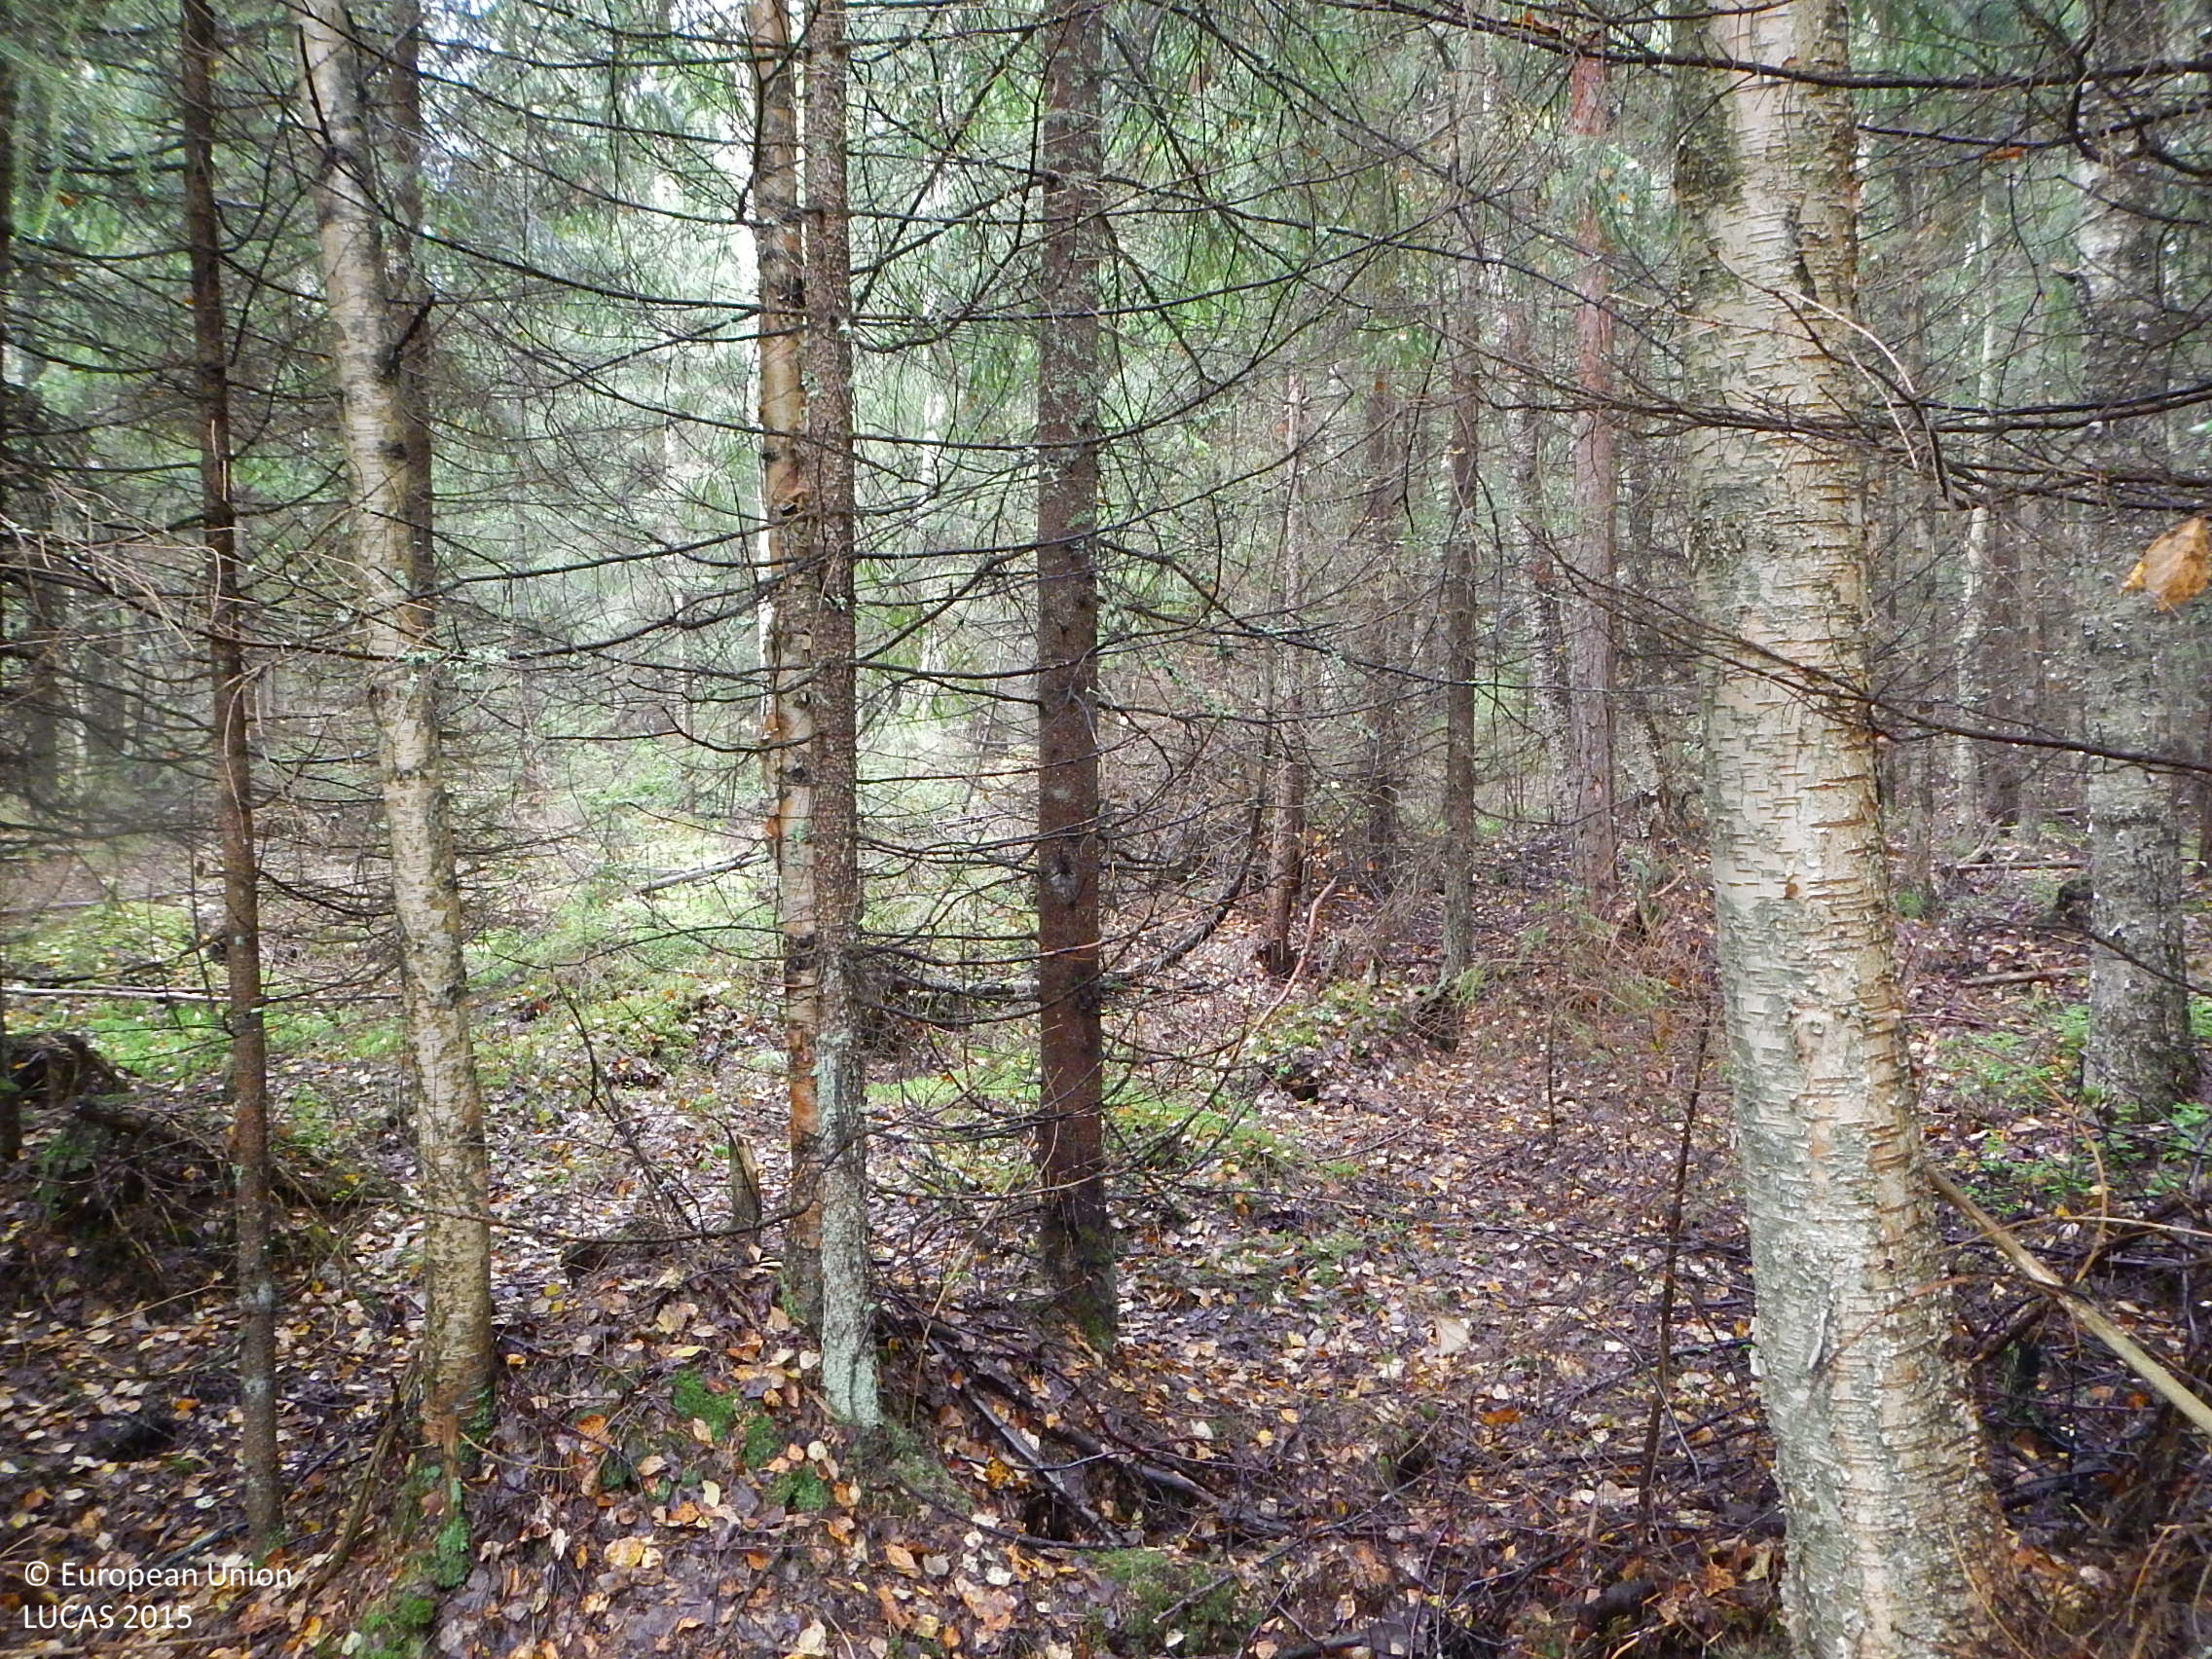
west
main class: Woodland
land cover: Other mixed woodland
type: boreal forest
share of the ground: > 75 %
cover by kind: coniferous forest trees 50 %, broadleaved forest trees 25 %, shrubs 10 %, unconsolidated bare surface 10 %, lichens and mosses 5 %
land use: Forestry
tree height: > 5 m
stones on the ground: 10 - 25 %
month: September
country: FI
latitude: 61.4148
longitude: 22.2575
